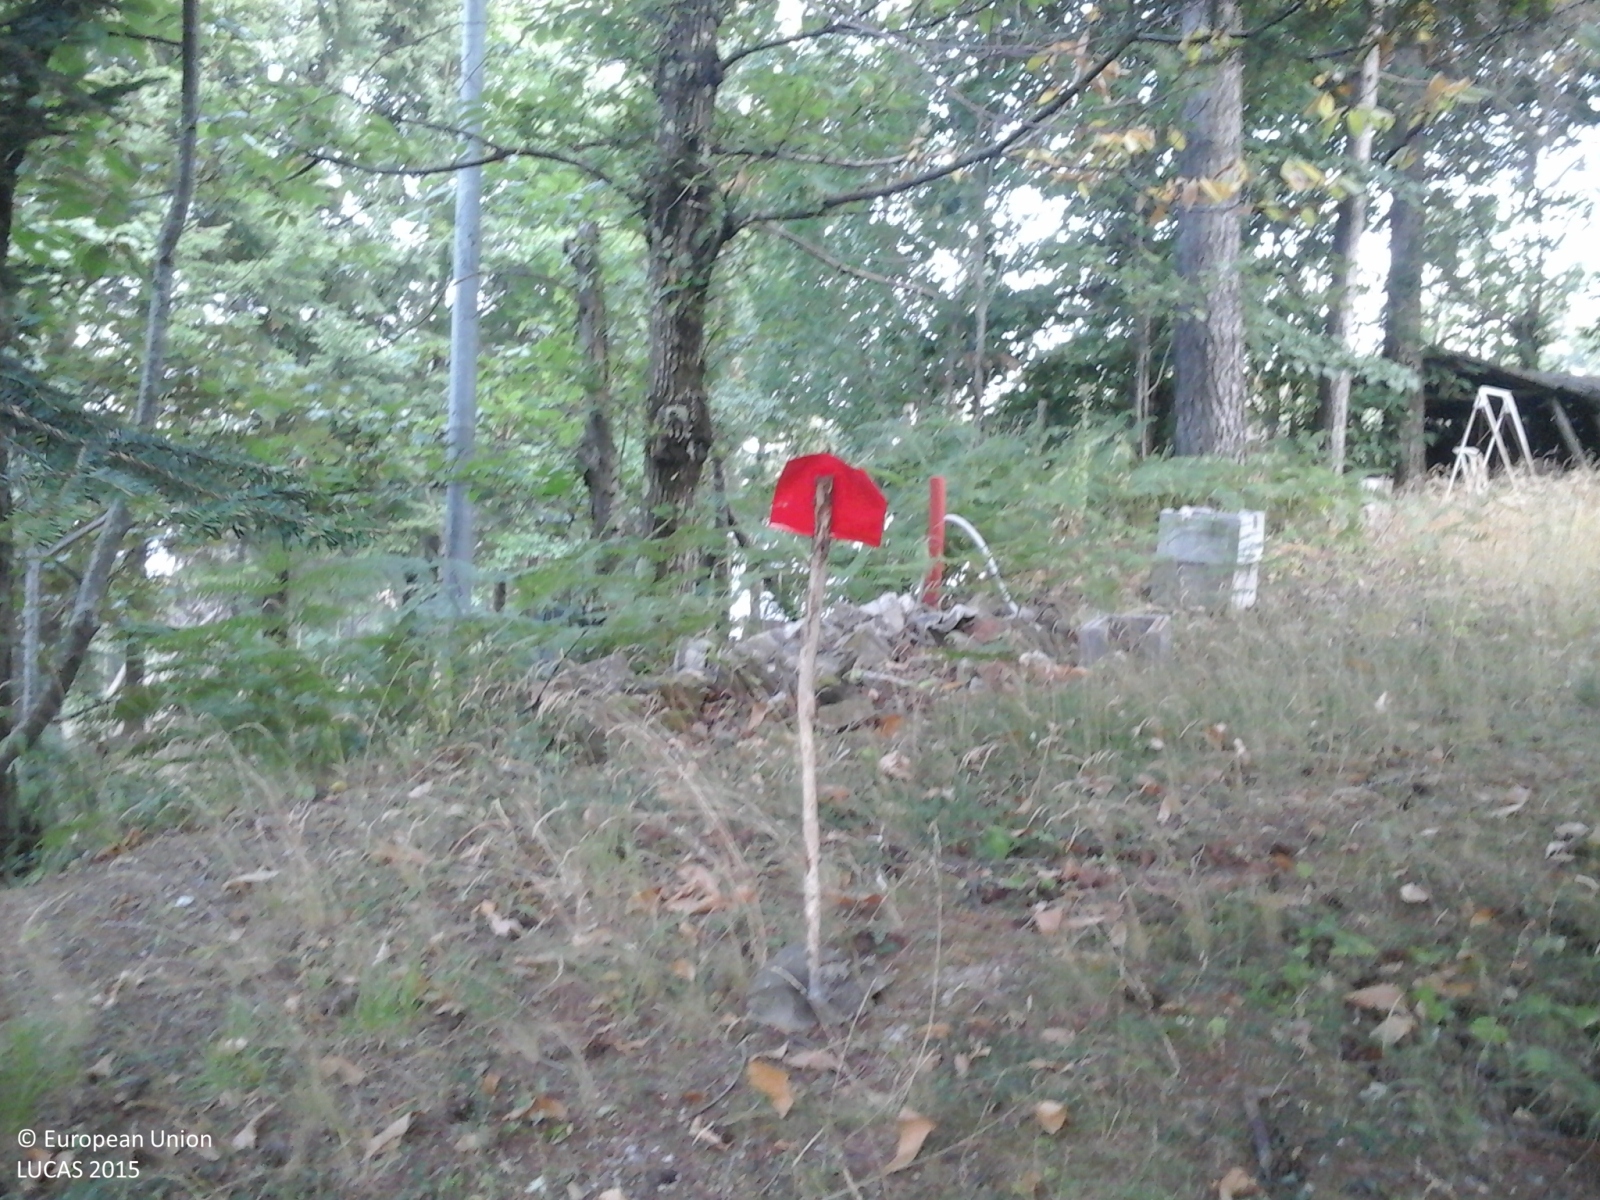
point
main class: Woodland
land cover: Other mixed woodland
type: thermophilous deciduous forest
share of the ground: > 75 %
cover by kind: broadleaved forest trees 75 %, coniferous forest trees 25 %
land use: Forestry
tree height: > 5 m
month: August
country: IT
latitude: 43.9157
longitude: 10.6335
